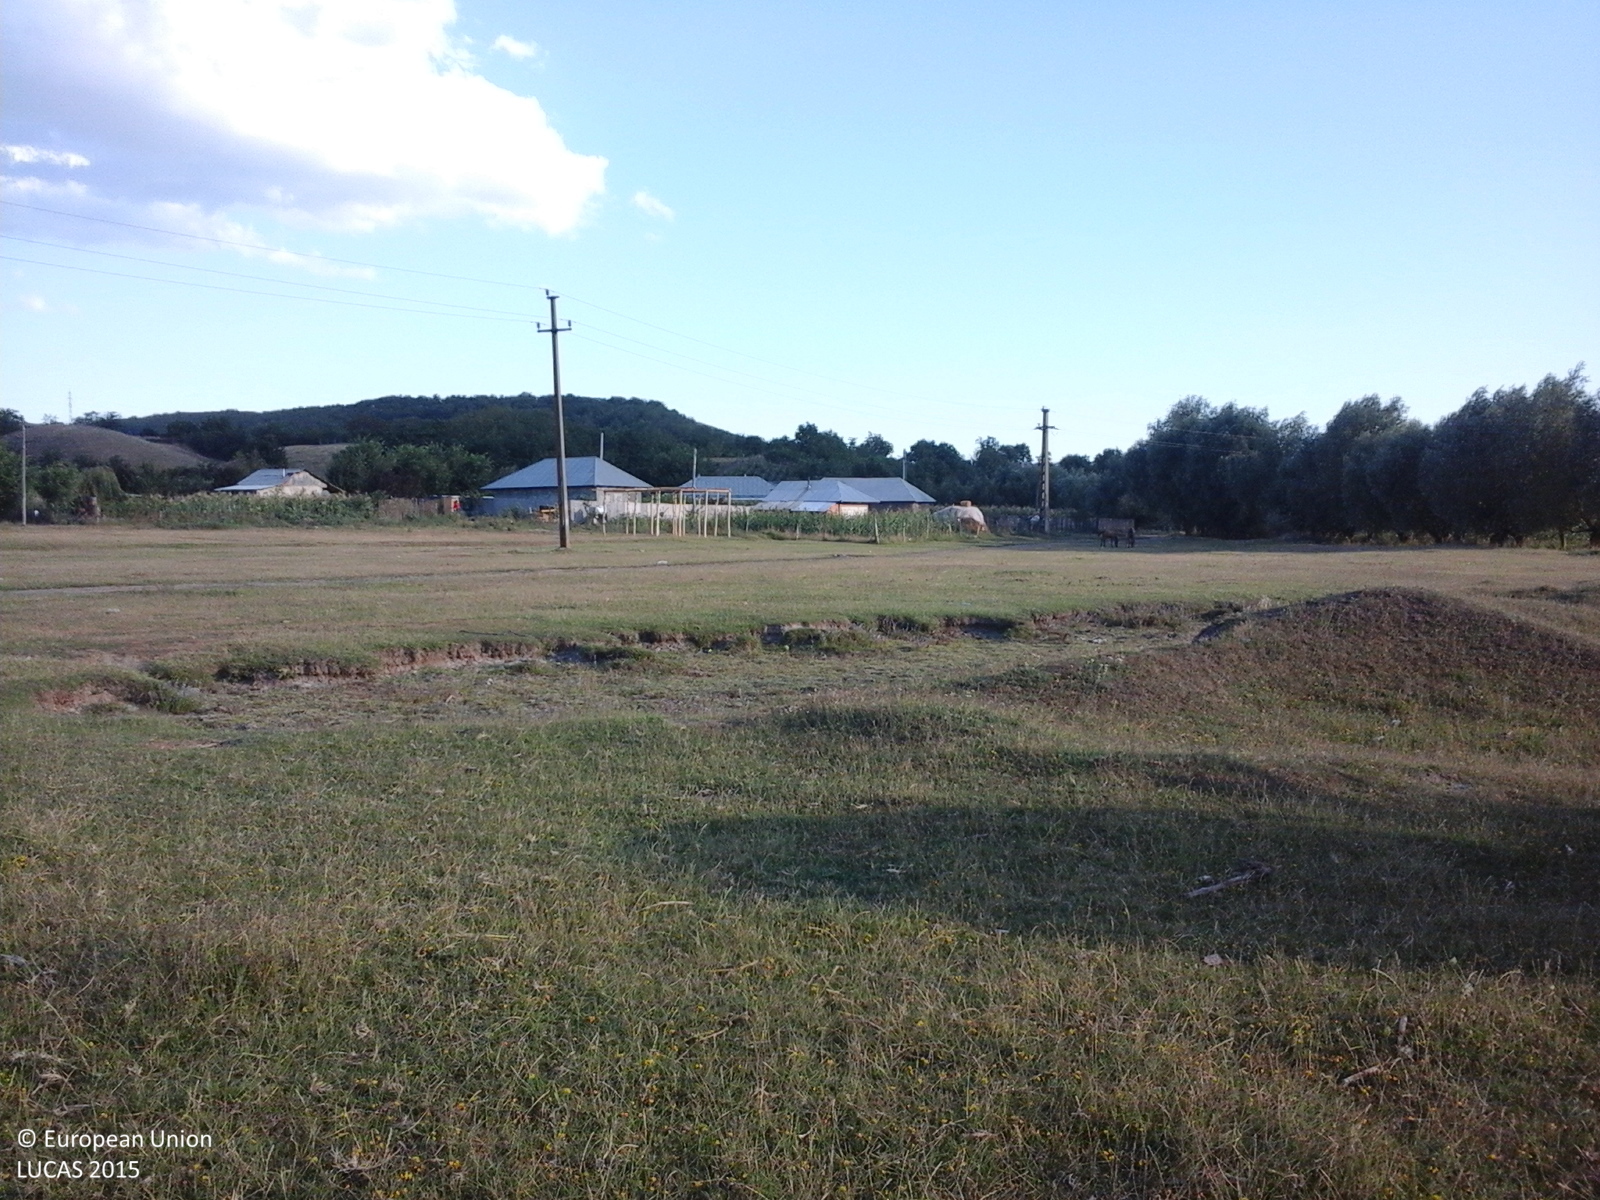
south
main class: Grassland
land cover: Grassland without tree/shrub cover
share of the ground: > 75 %
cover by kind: herbaceous plants 100 %
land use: Agriculture (excluding fallow land and kitchen gardens)
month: July
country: RO
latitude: 46.2647
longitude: 27.5613
